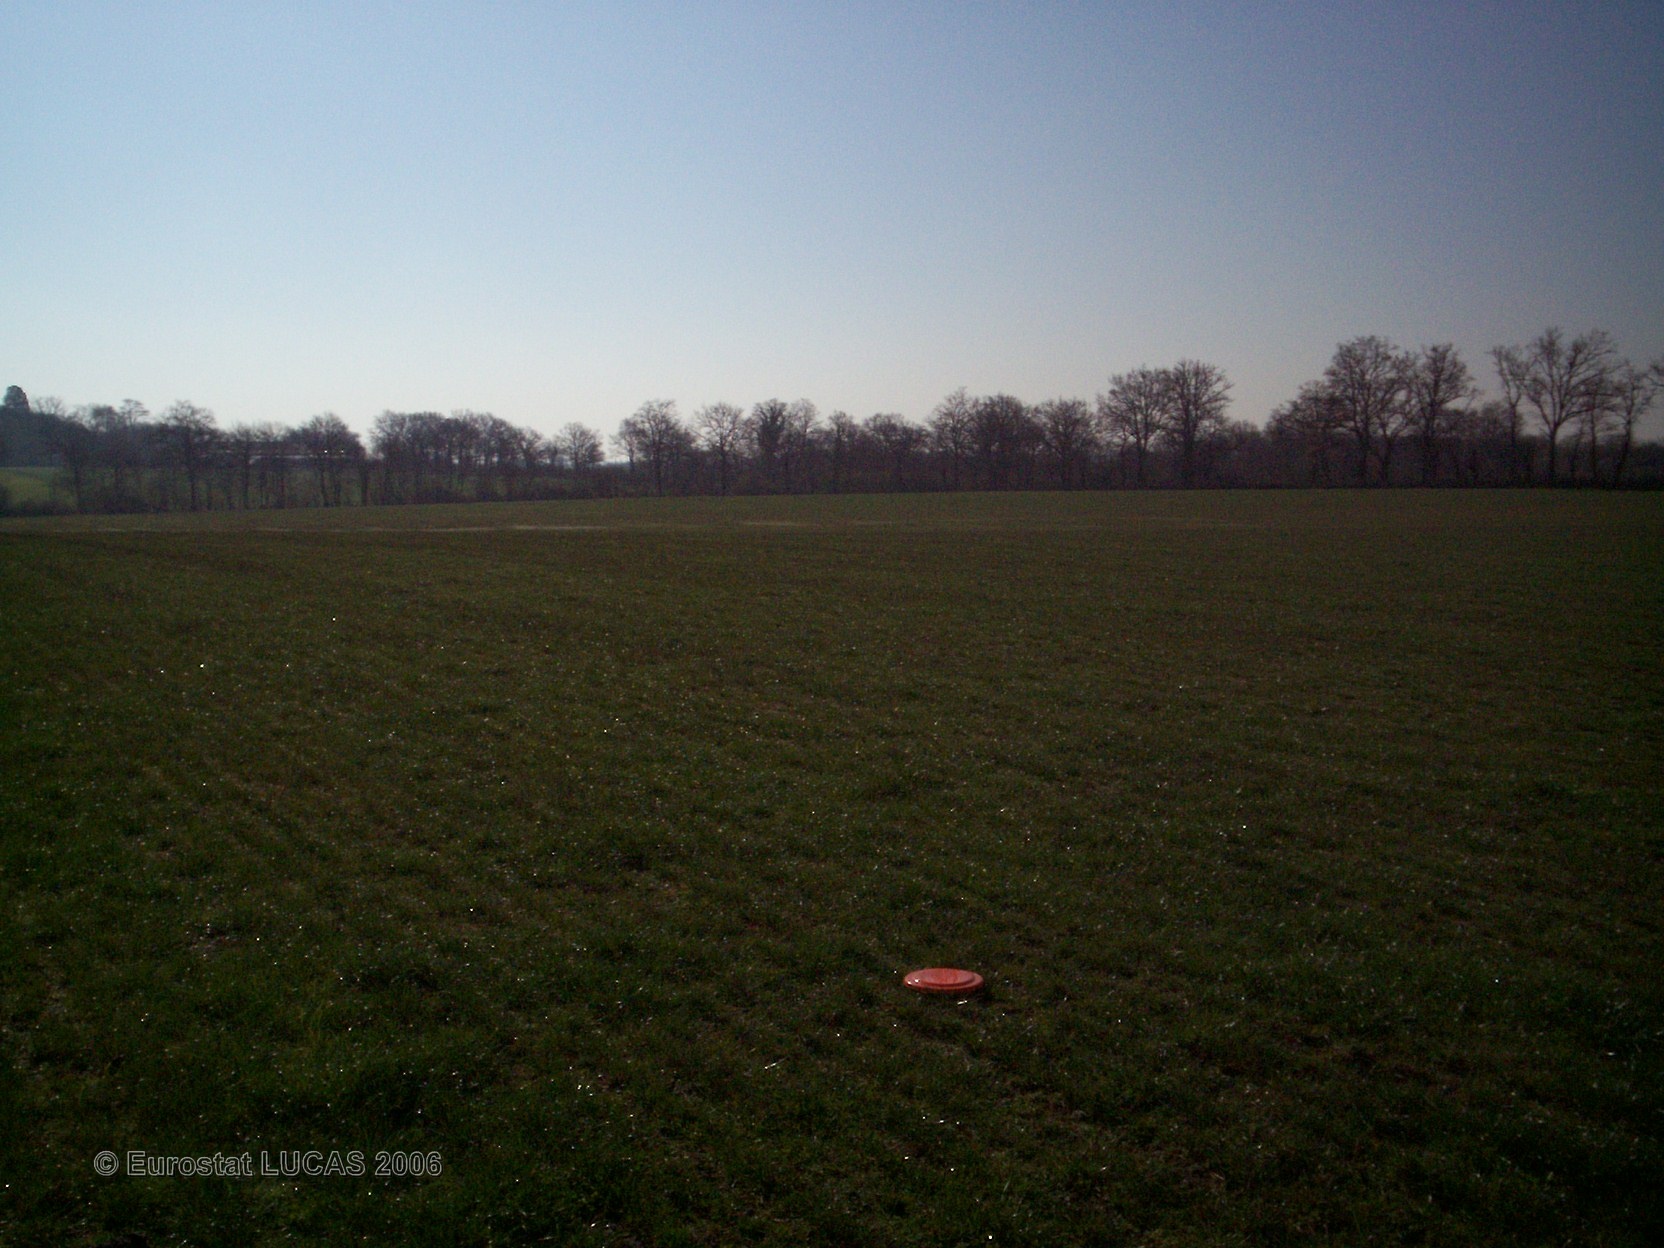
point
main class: Grassland
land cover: Grassland without tree/shrub cover
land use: Agriculture (excluding fallow land and kitchen gardens)
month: April
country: FR
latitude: 46.3230
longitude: 1.0908
